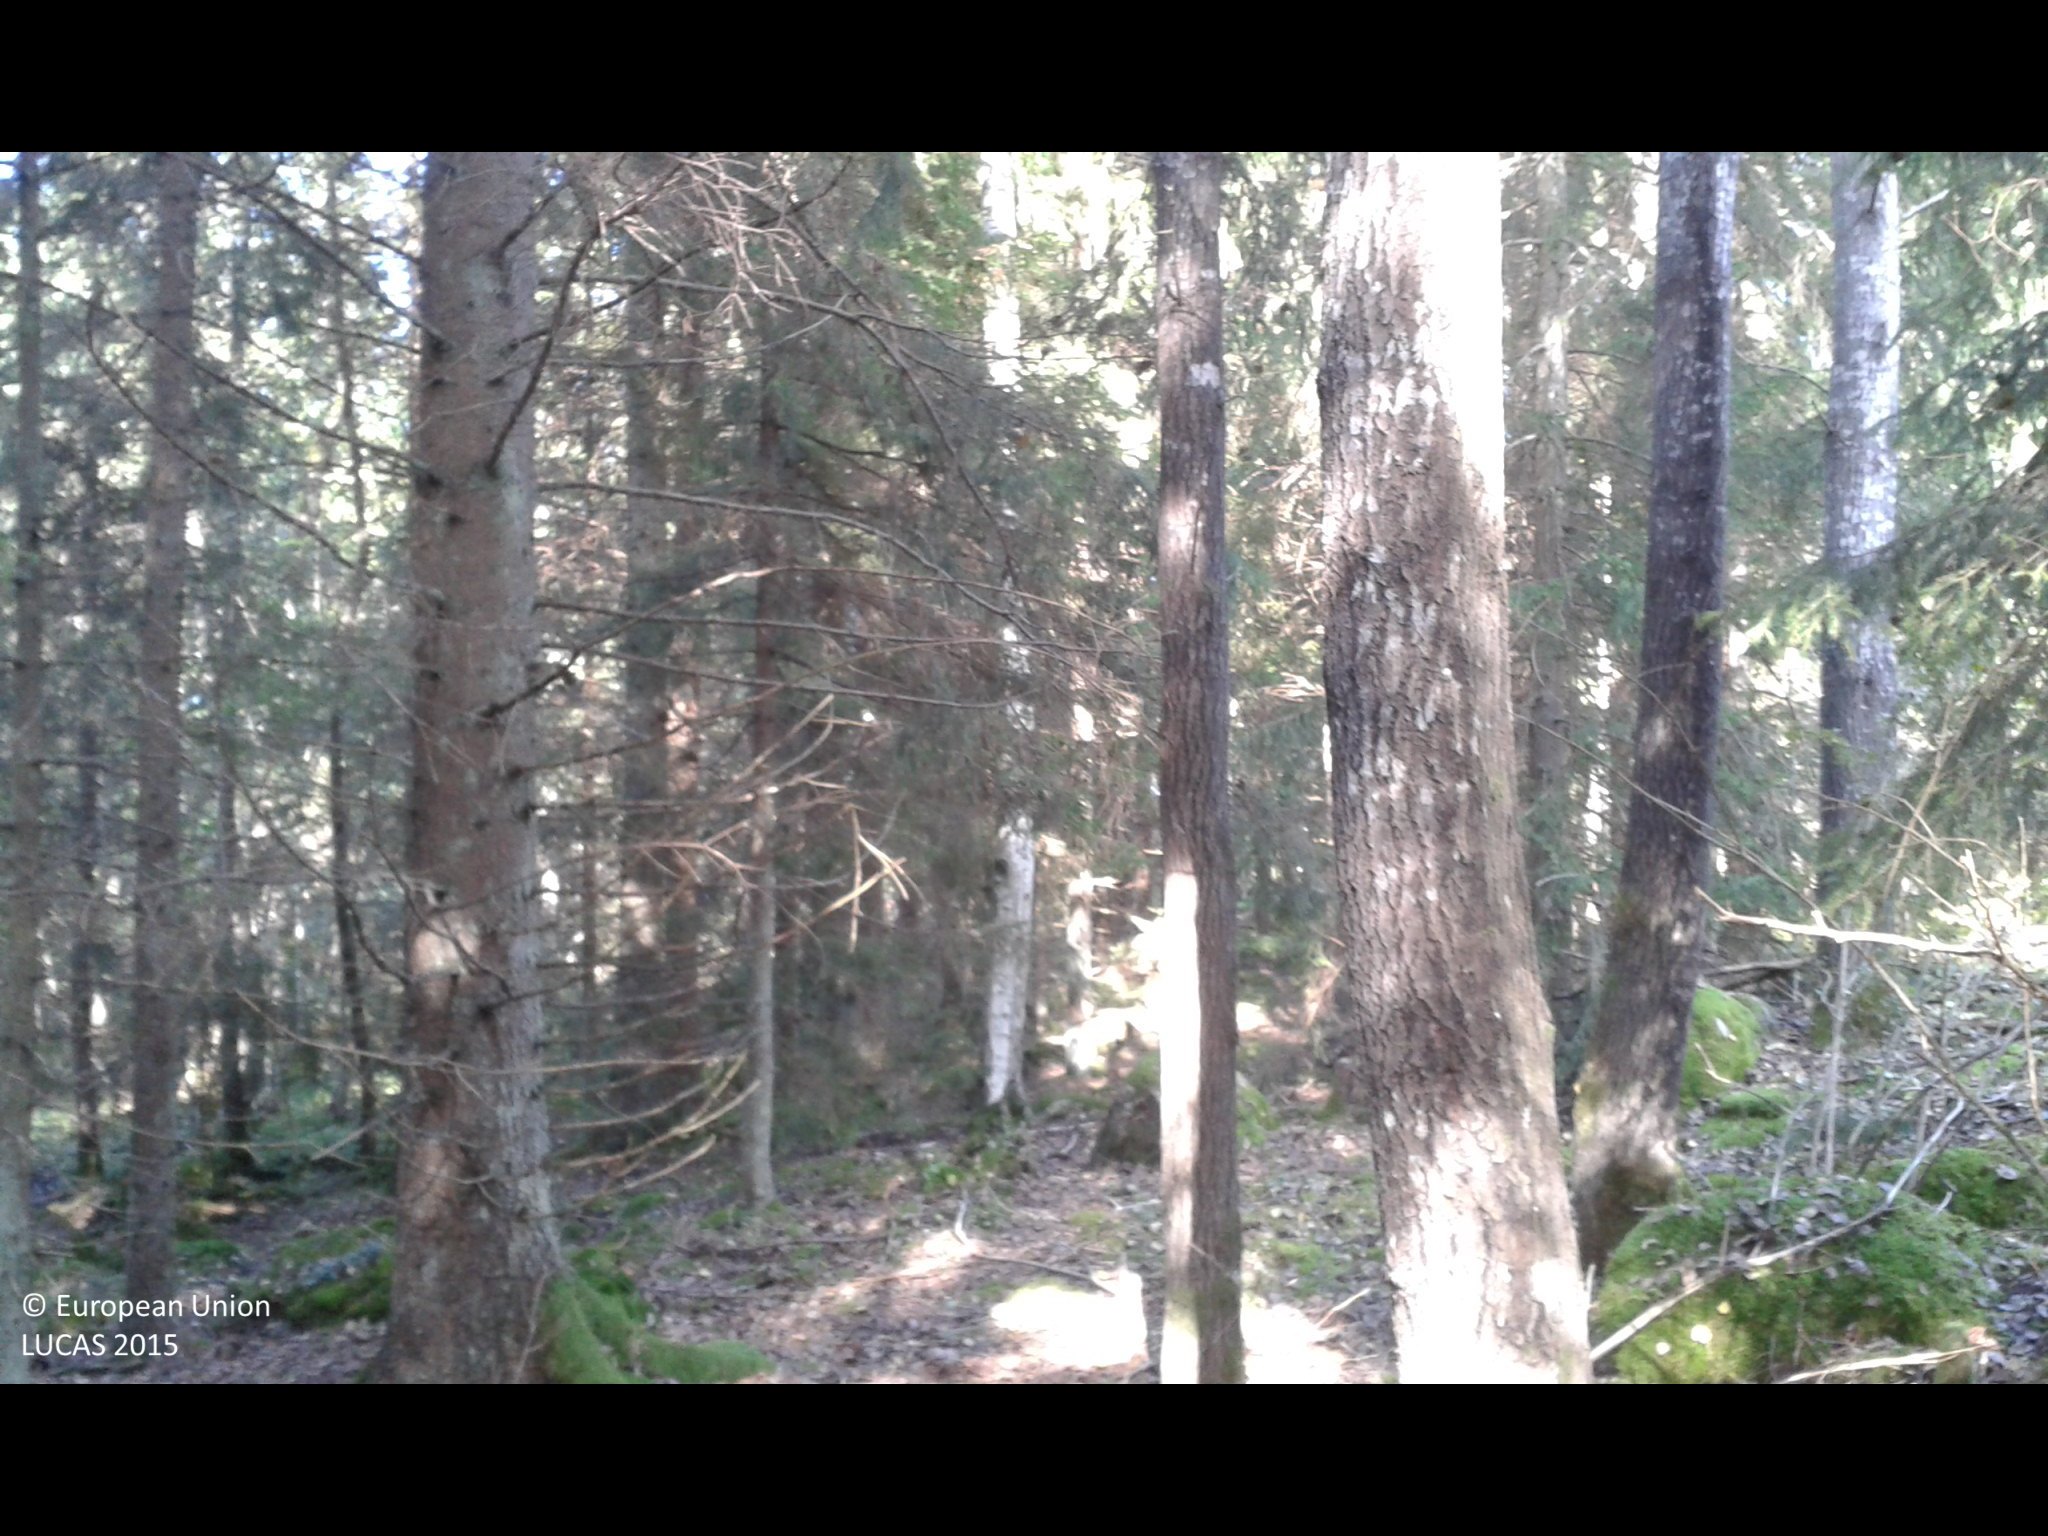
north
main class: Woodland
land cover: Spruce dominated coniferous woodland
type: boreal forest
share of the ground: > 75 %
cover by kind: coniferous forest trees 70 %, broadleaved forest trees 10 %, herbaceous plants 10 %, lichens and mosses 10 %
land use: Forestry
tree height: > 5 m
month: September
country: SE
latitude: 59.0277
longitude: 17.4012
